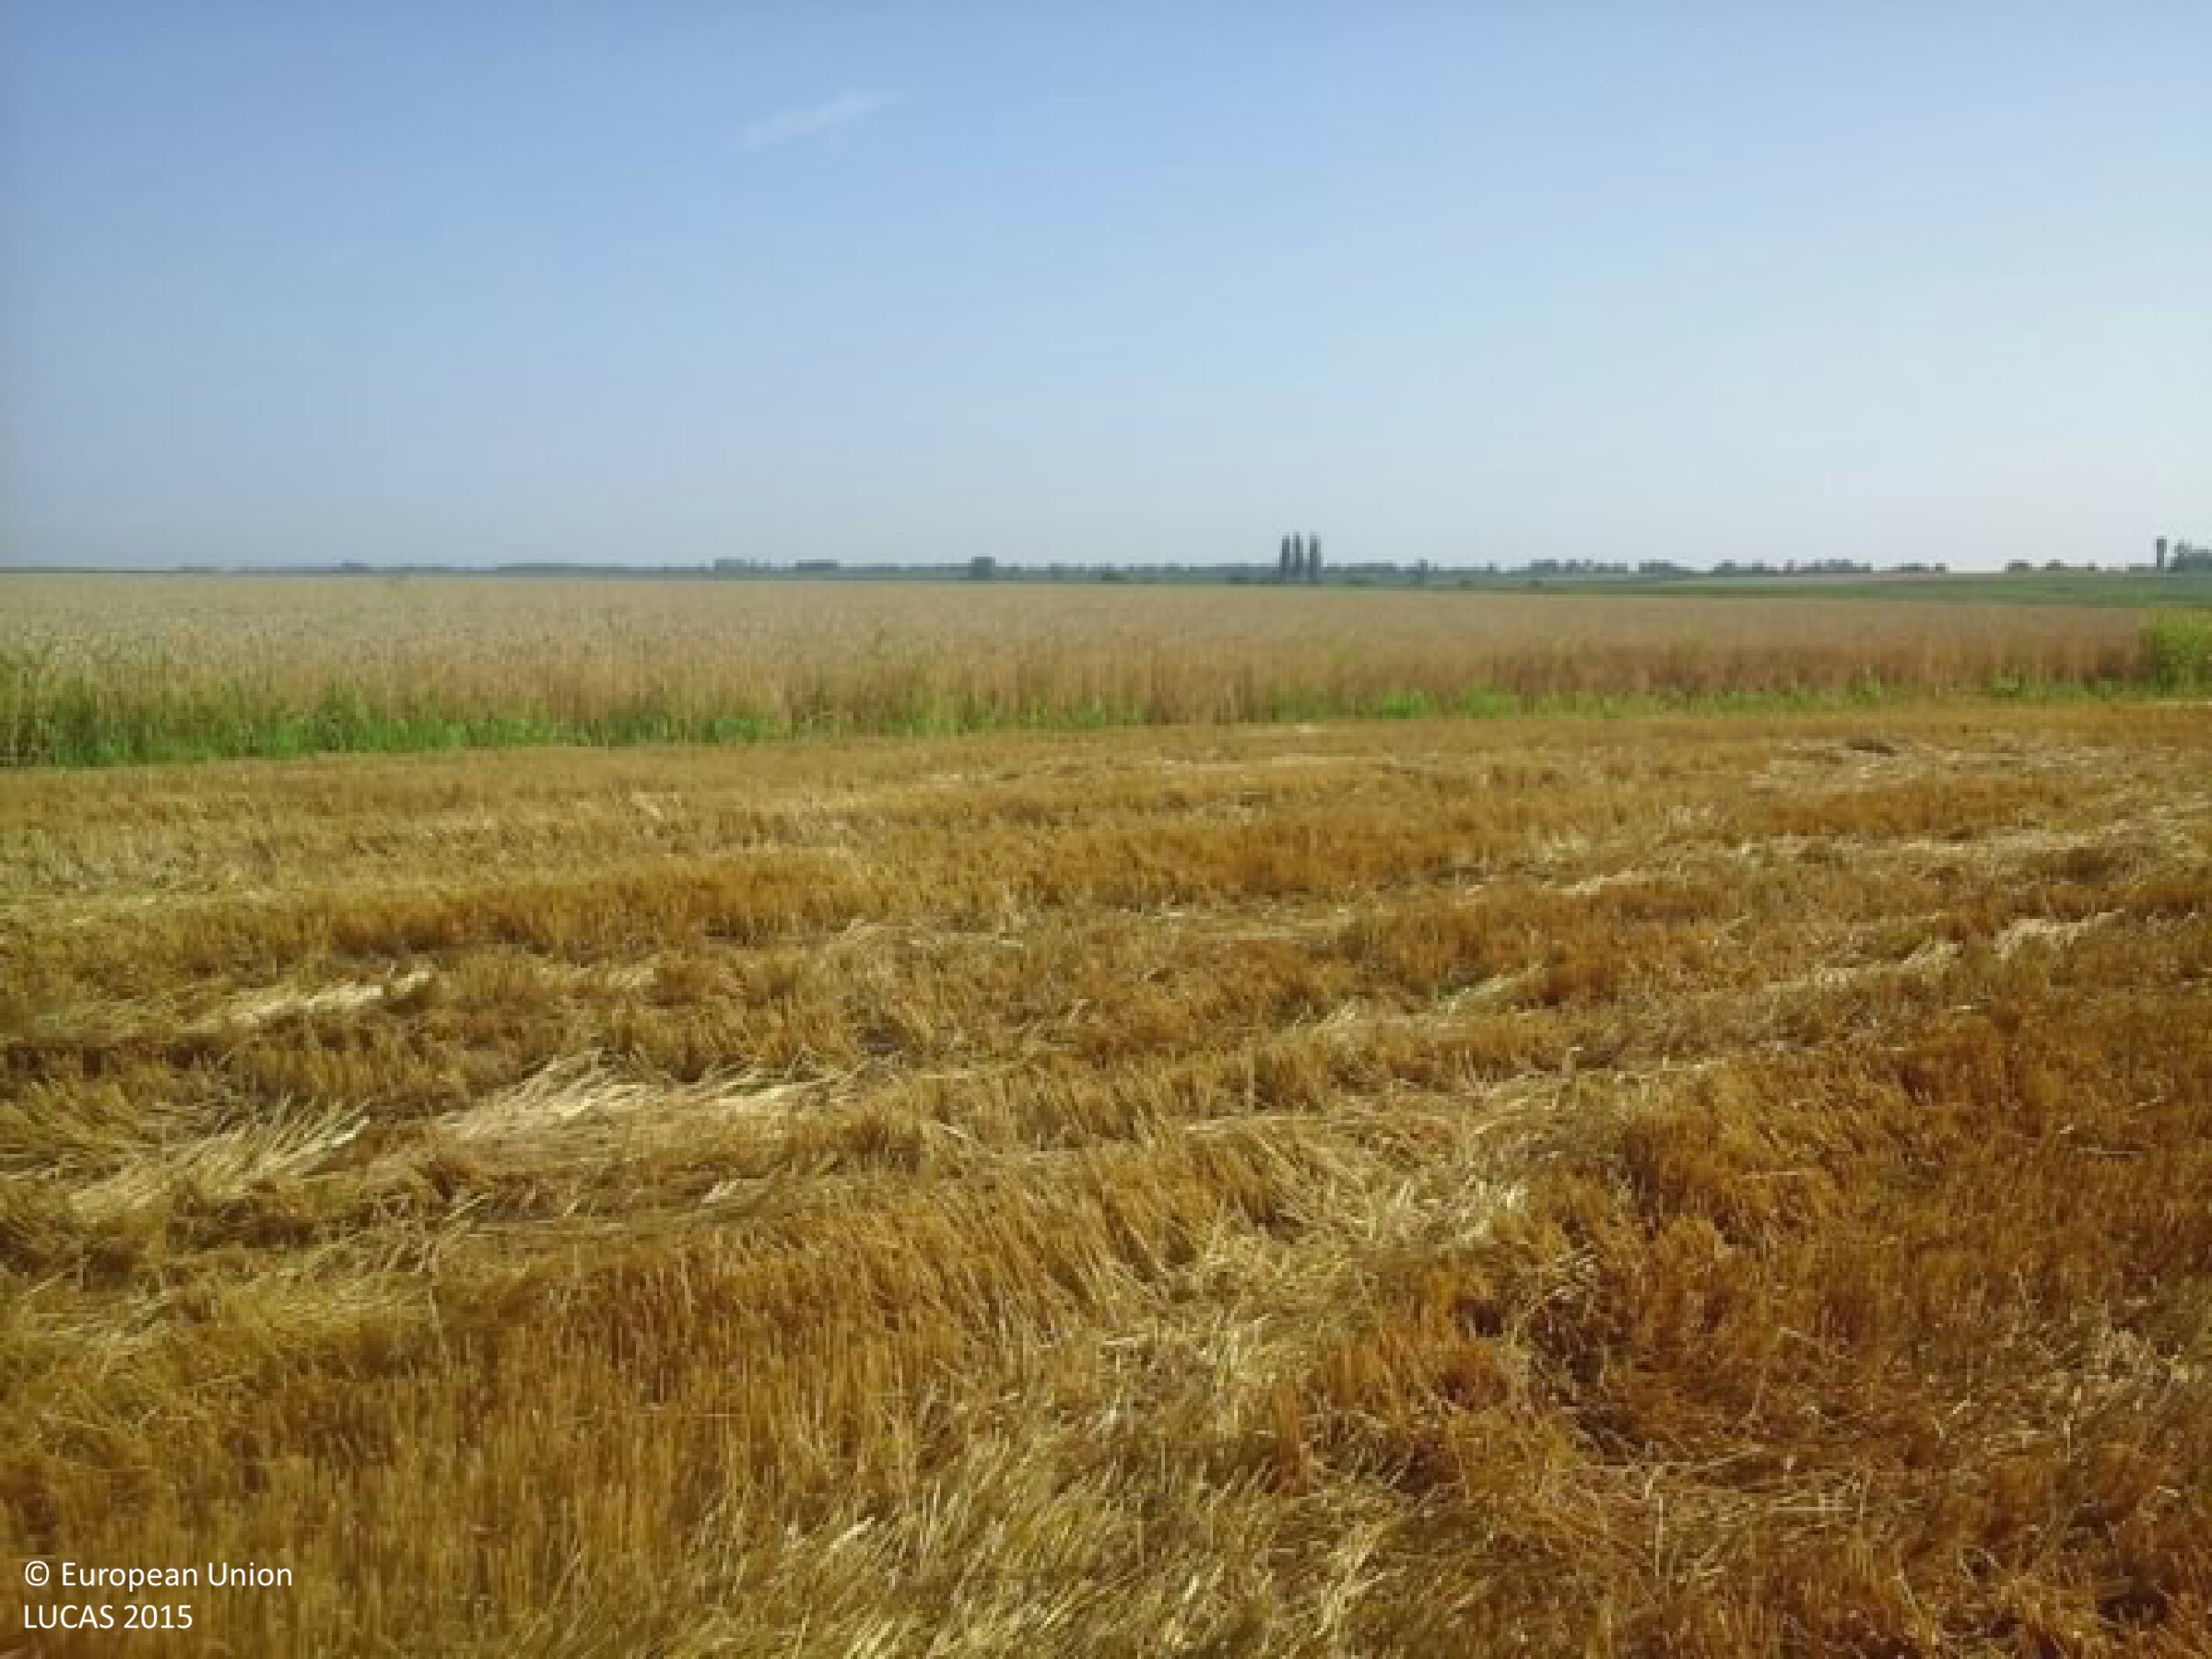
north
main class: Cropland
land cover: Barley
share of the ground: 25 - 50 %
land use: Agriculture (excluding fallow land and kitchen gardens)
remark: Harvested field
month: July
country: HU
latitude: 46.0421
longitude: 19.0187
